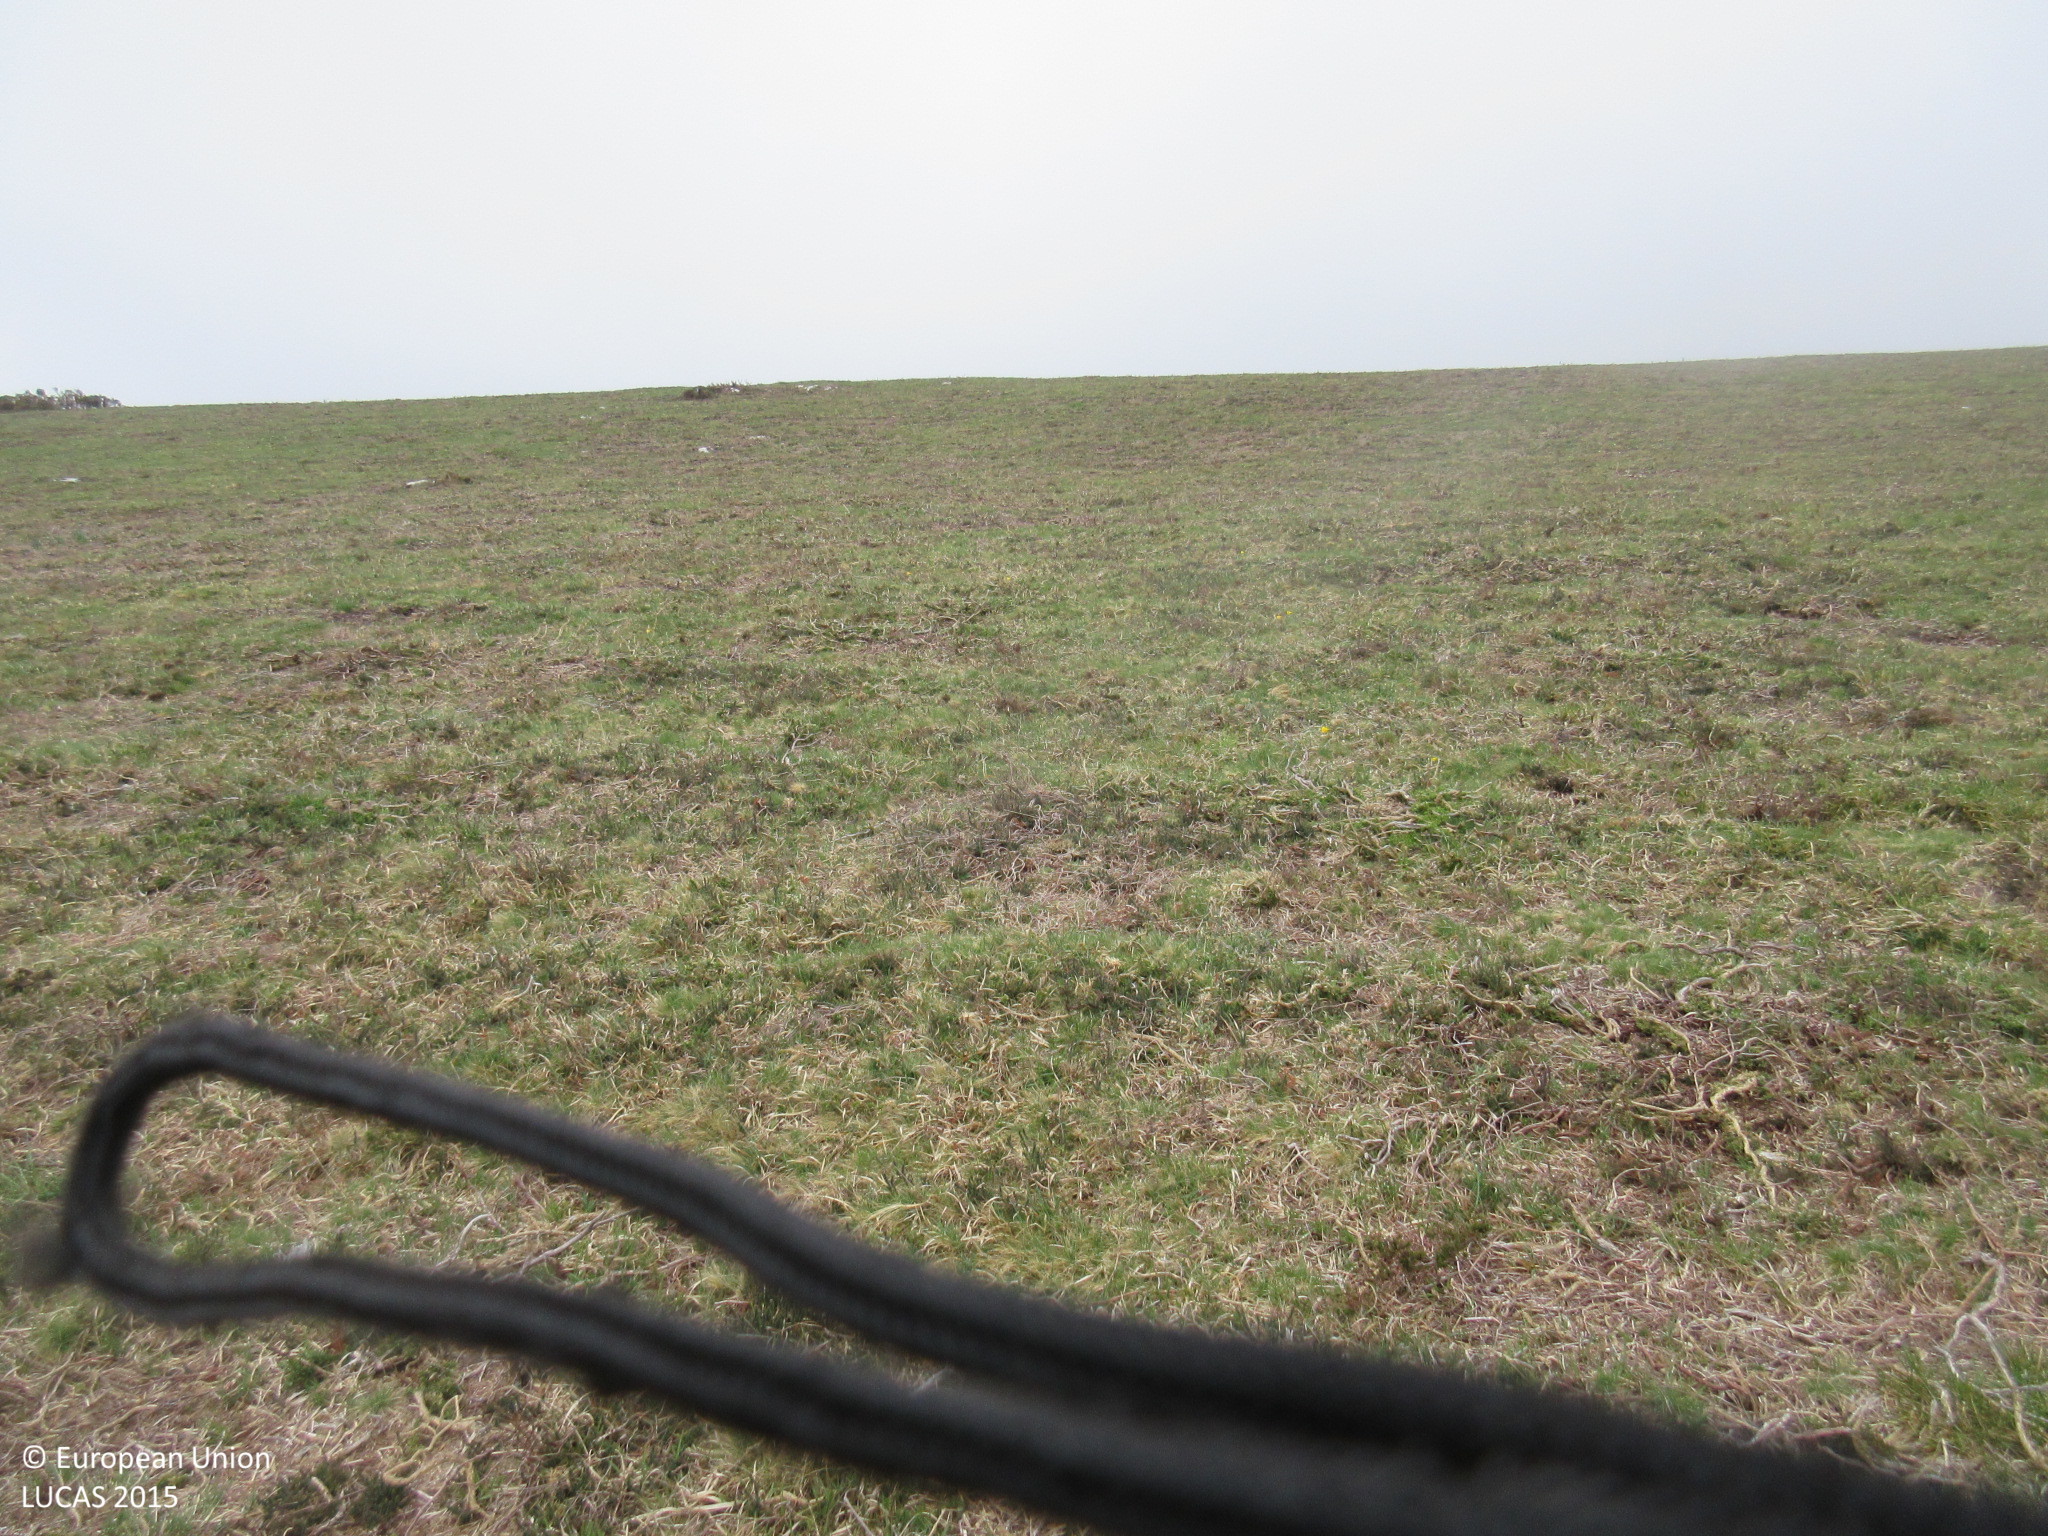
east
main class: Grassland
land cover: Grassland without tree/shrub cover
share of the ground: > 75 %
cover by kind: herbaceous plants 100 %
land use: Agriculture (excluding fallow land and kitchen gardens)
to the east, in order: Grassland without tree/shrub cover; Shrubland without tree cover; Rivers and streams; Shrubland without tree cover; Grassland without tree/shrub cover
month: April
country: ES
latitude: 43.3613
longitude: -6.9831
